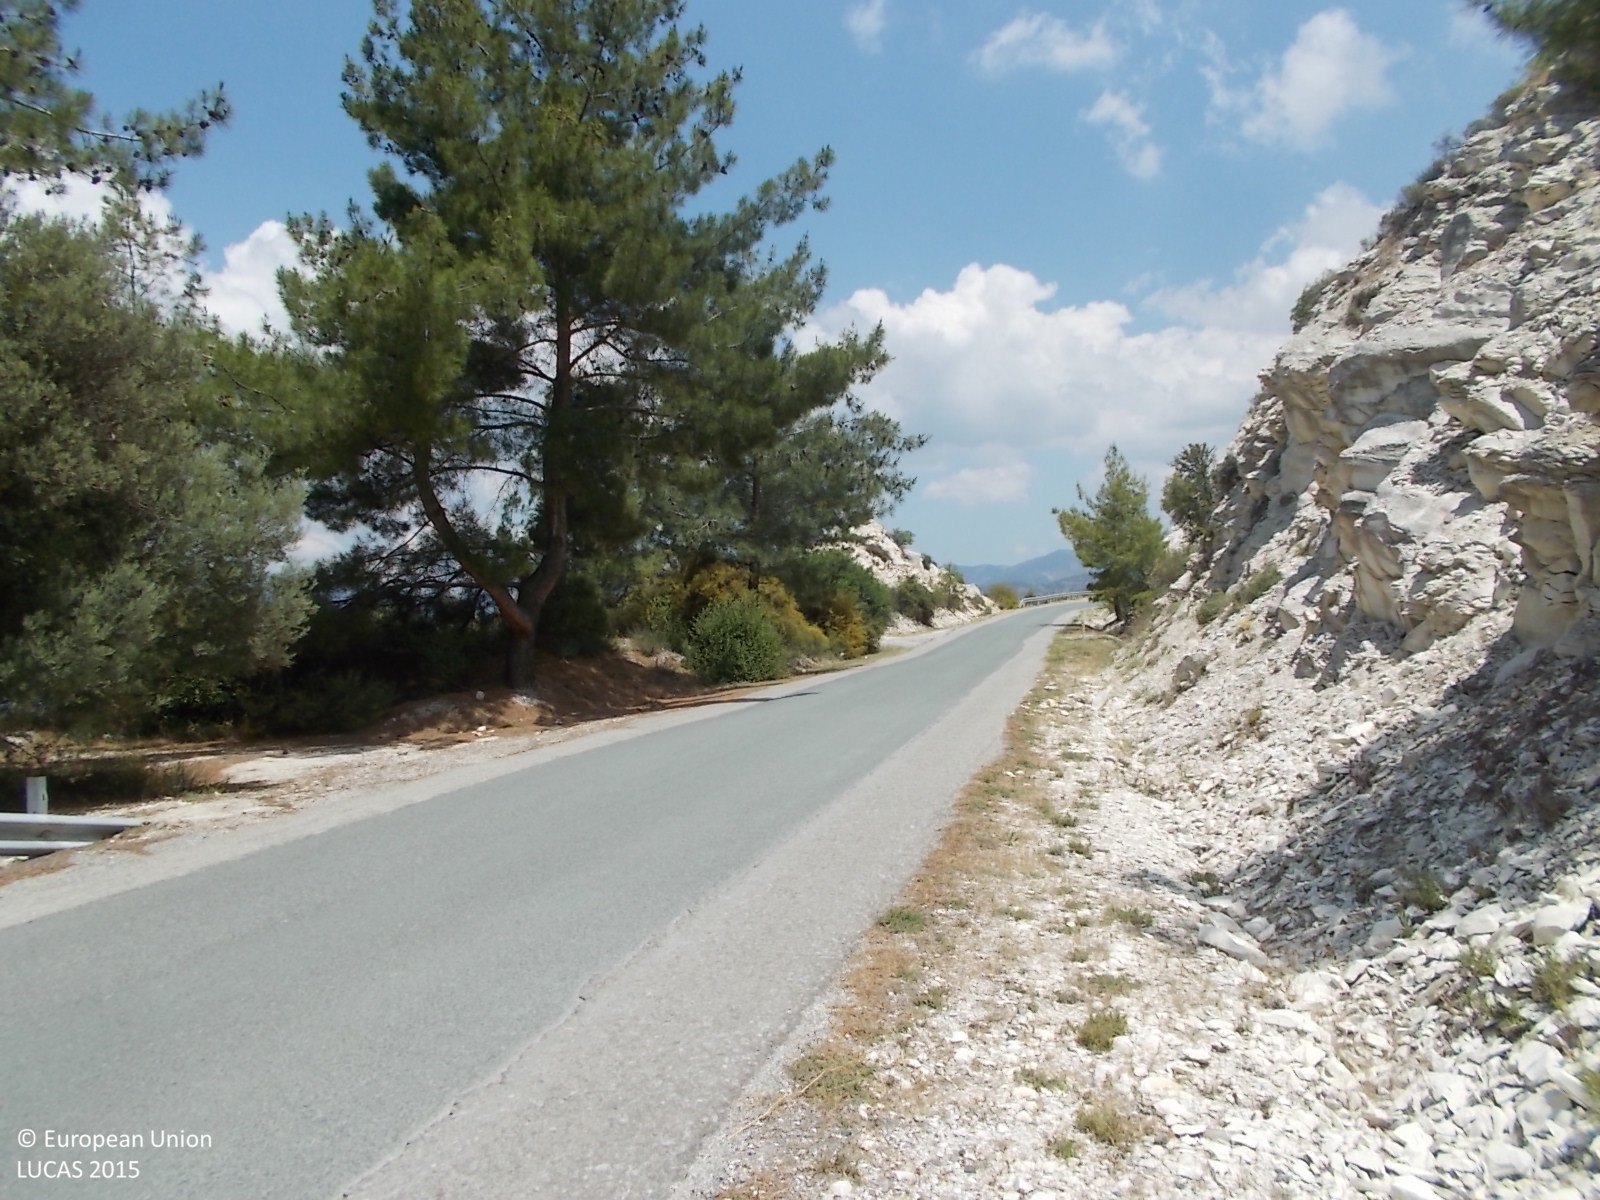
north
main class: Shrubland
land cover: Shrubland with sparse tree cover
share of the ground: > 75 %
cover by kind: shrubs 70 %, unconsolidated bare surface 15 %, consolidated bare surface 10 %, coniferous forest trees 5 %
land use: Semi-natural and natural areas not in use
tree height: > 5 m
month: June
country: CY
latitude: 34.8705
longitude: 32.7729
